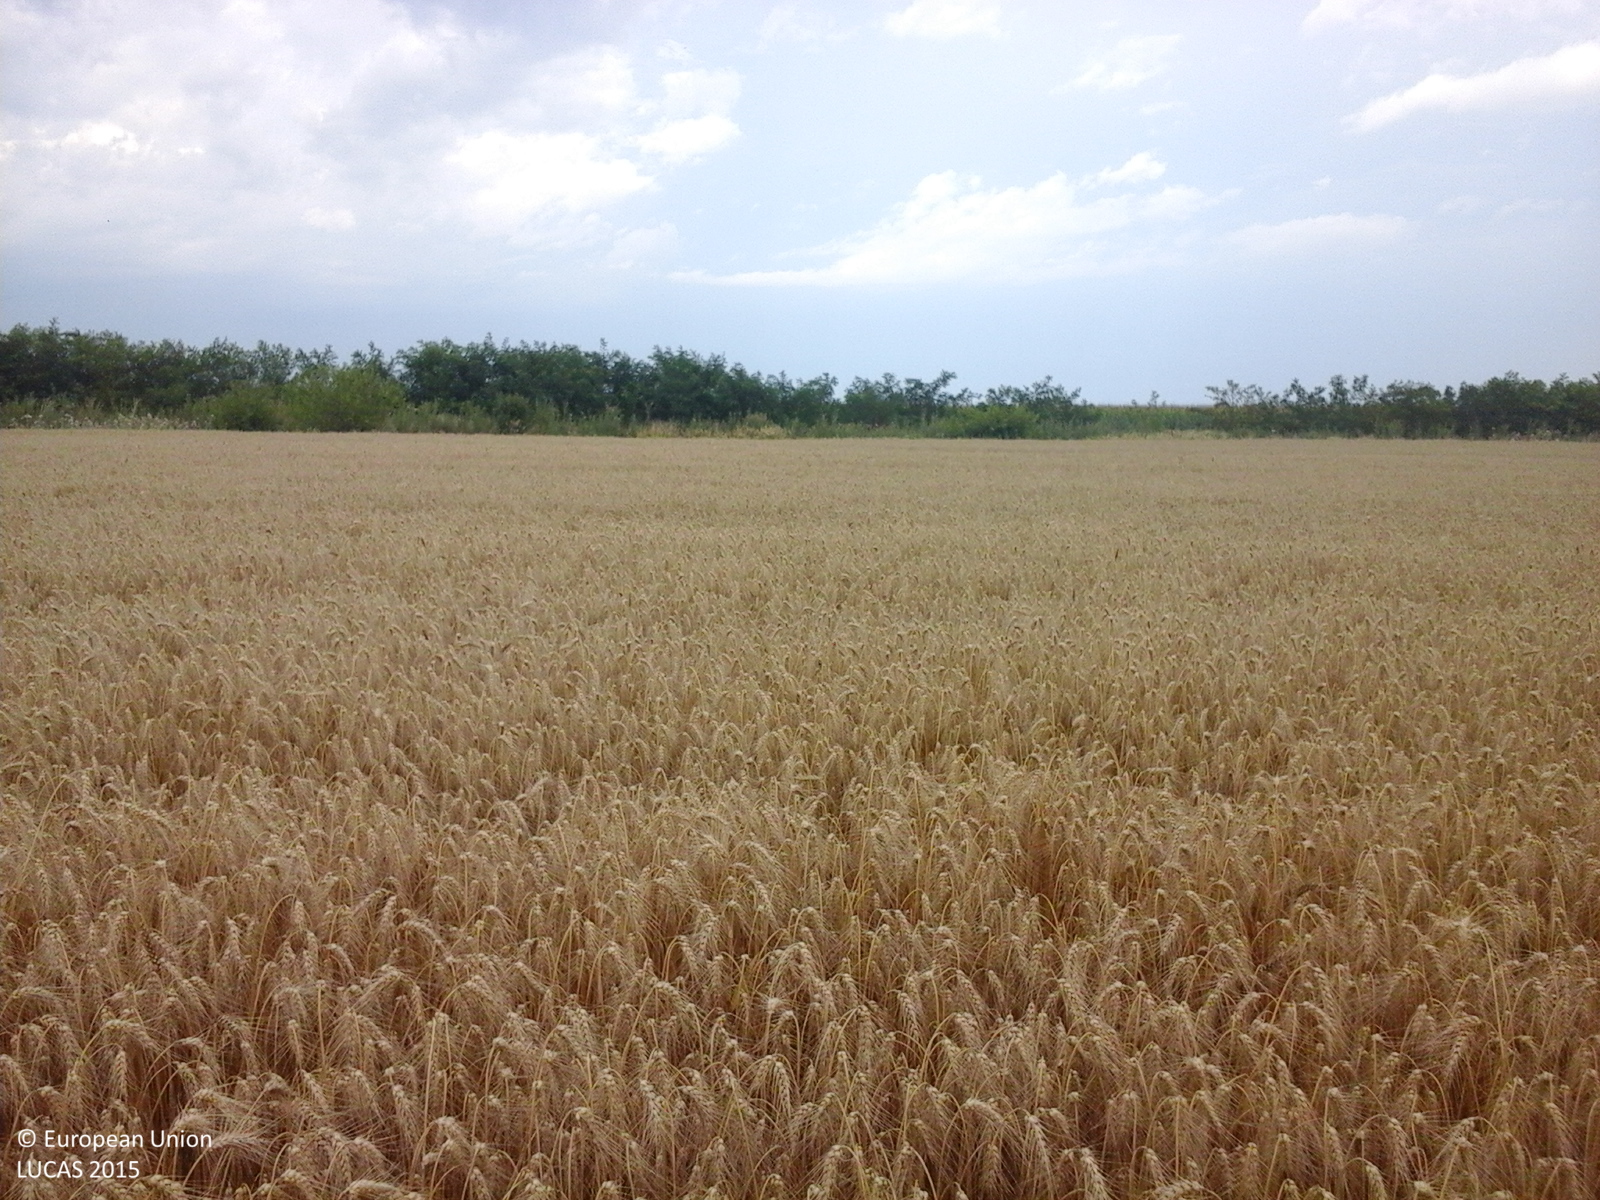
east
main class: Cropland
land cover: Common wheat
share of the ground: > 75 %
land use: Agriculture (excluding fallow land and kitchen gardens)
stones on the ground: < 10 %
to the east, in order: Common wheat; Grass margins; Ditches and canals; Grassland with sparse tree/shrub cover; Maize
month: July
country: RO
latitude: 44.0527
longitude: 24.4070
